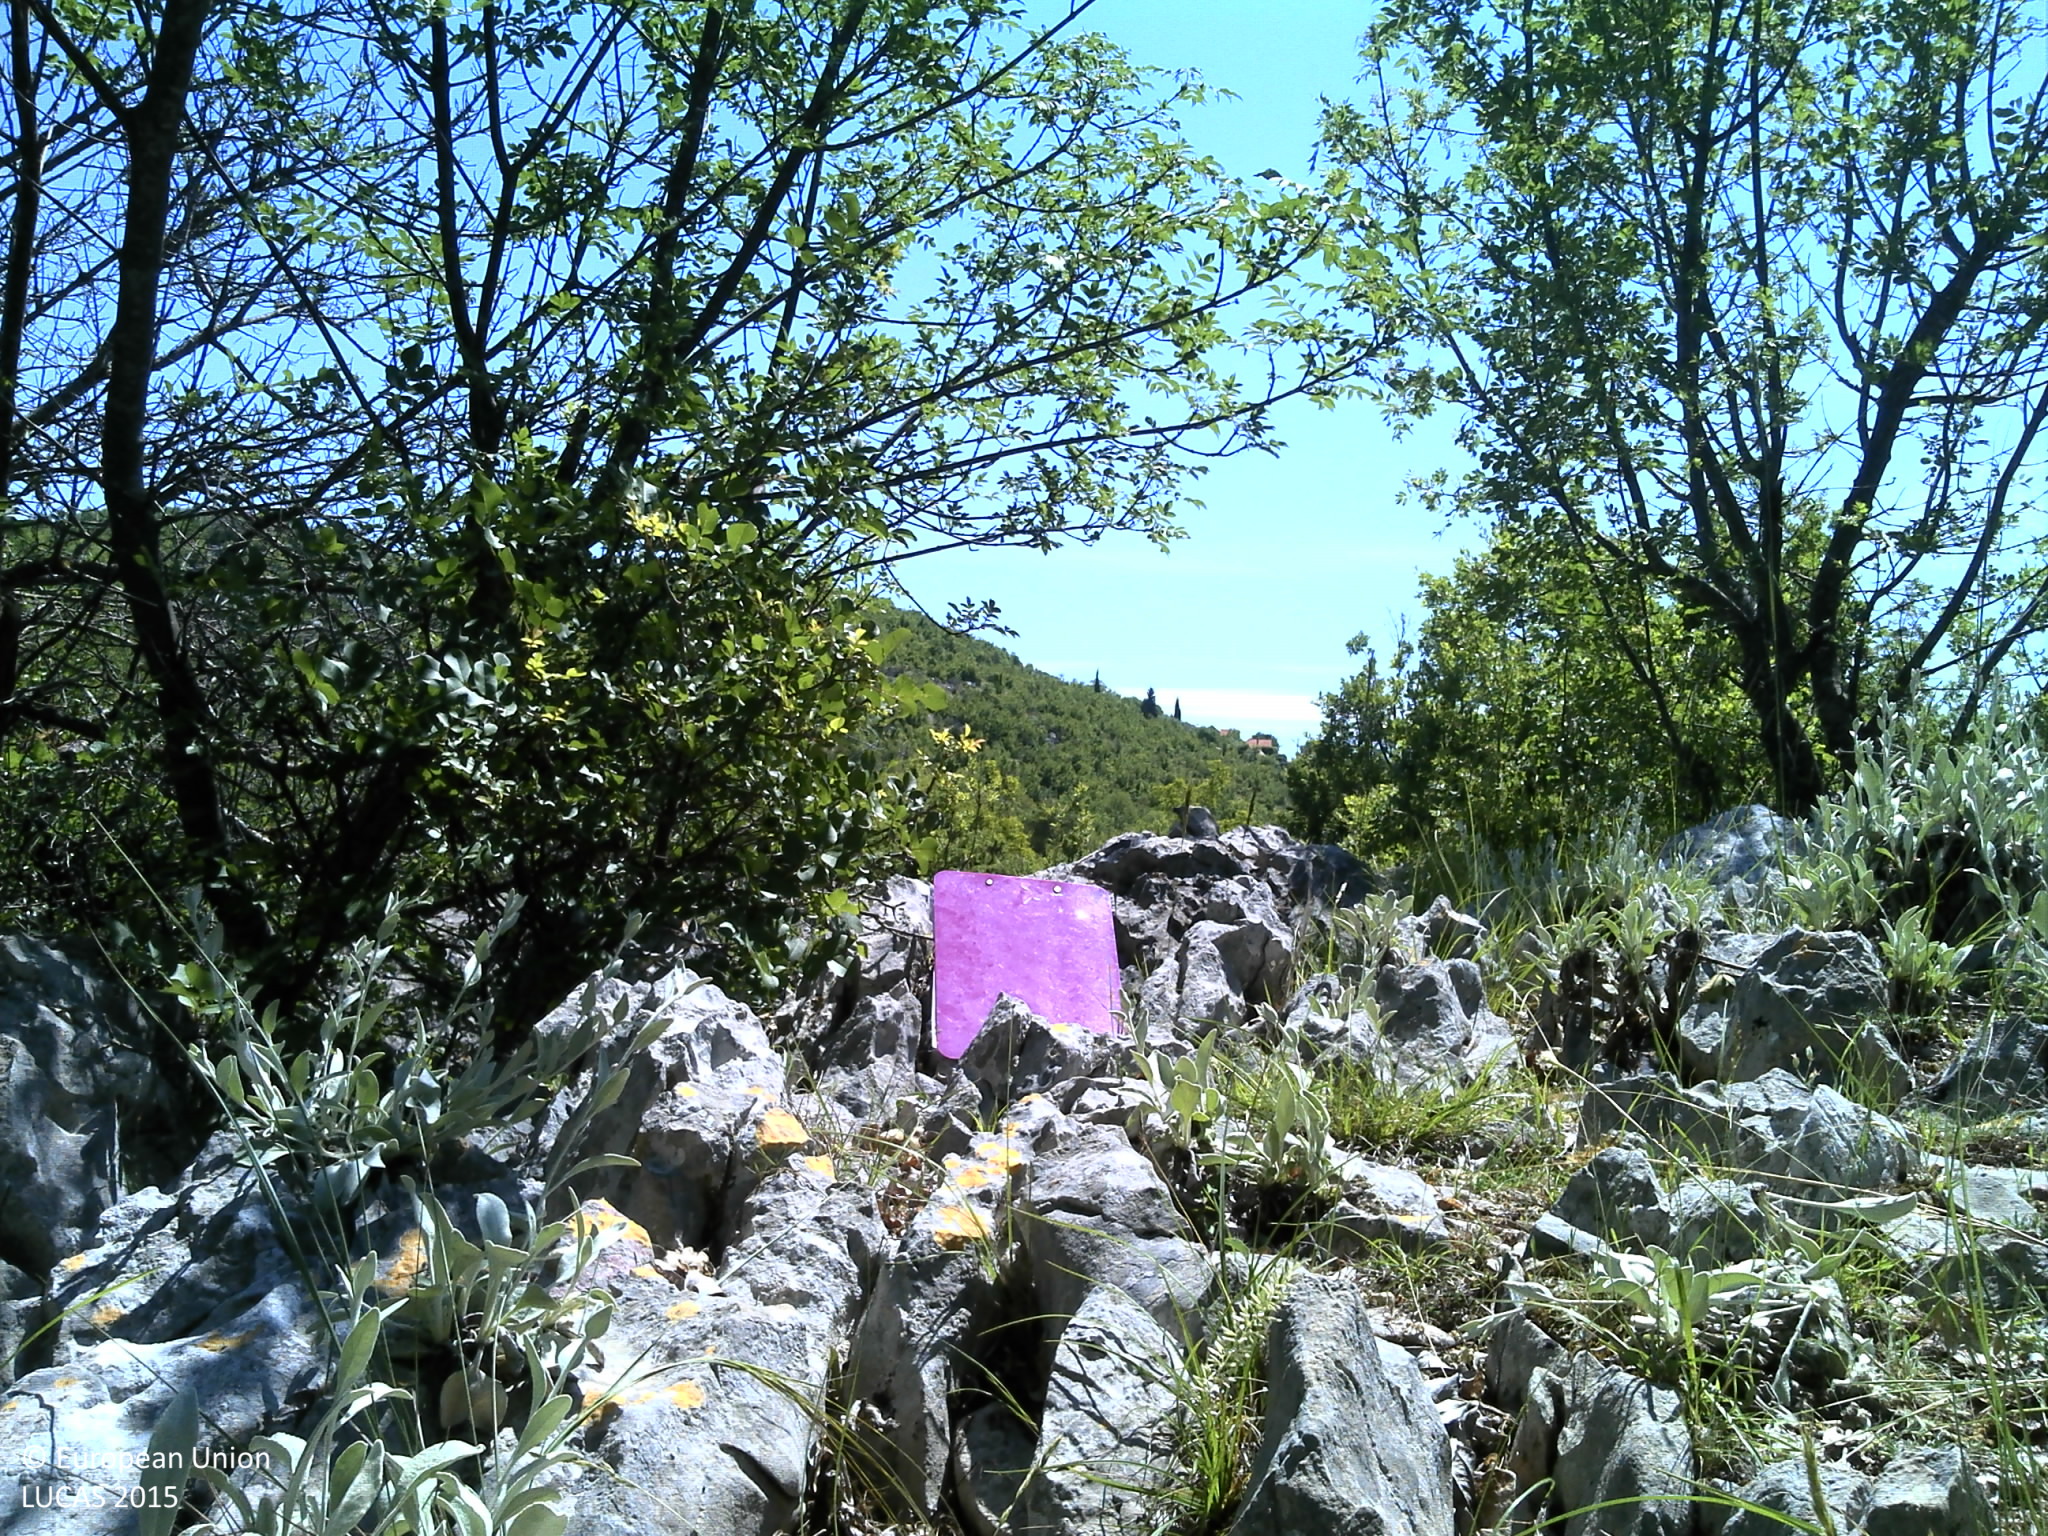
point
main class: Woodland
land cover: Broadleaved woodland
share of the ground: 25 - 50 %
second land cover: Spontaneously vegetated surfaces
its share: 25 - 50 %
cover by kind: broadleaved forest trees 30 %, herbaceous plants 25 %, consolidated bare surface 20 %, unconsolidated bare surface 15 %, shrubs 10 %
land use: Forestry
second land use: Agriculture (excluding fallow land and kitchen gardens)
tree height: < 5 m
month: June
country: HR
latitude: 43.7663
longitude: 16.2150
